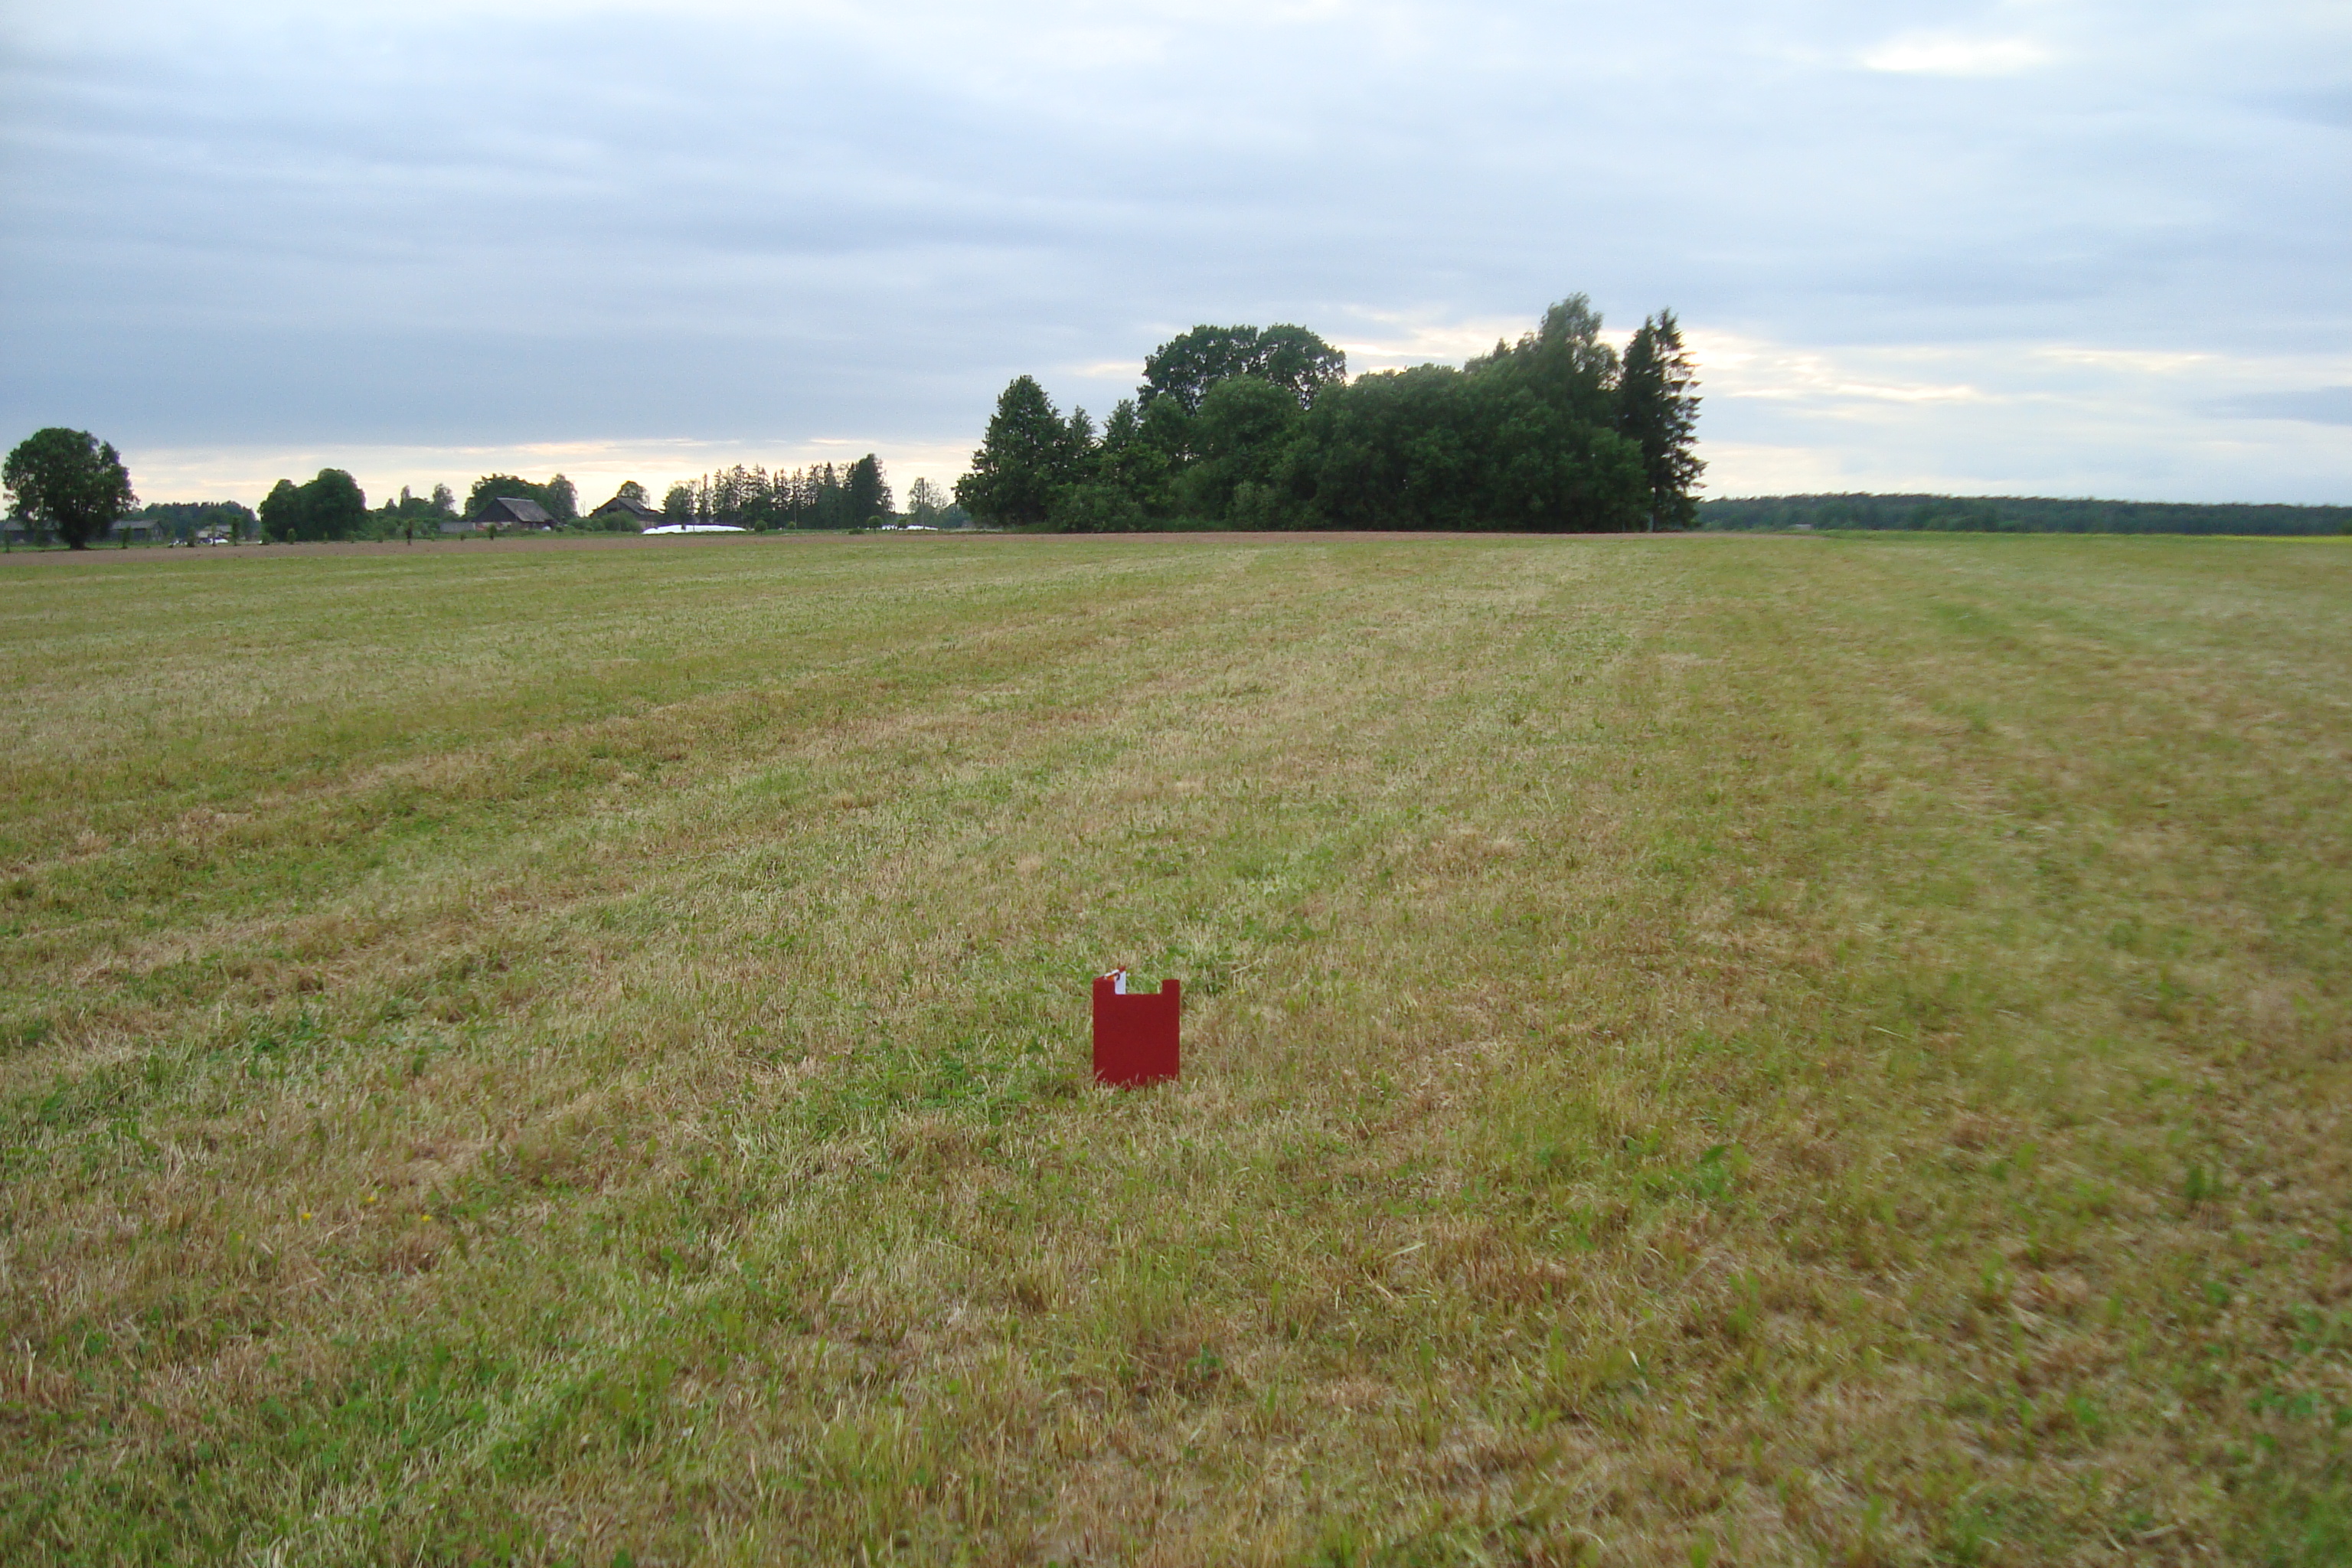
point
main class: Grassland
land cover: Grassland without tree/shrub cover
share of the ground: > 75 %
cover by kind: herbaceous plants 100 %
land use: Agriculture (excluding fallow land and kitchen gardens)
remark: Harvested field
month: June
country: LV
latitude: 57.2172
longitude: 26.4196
